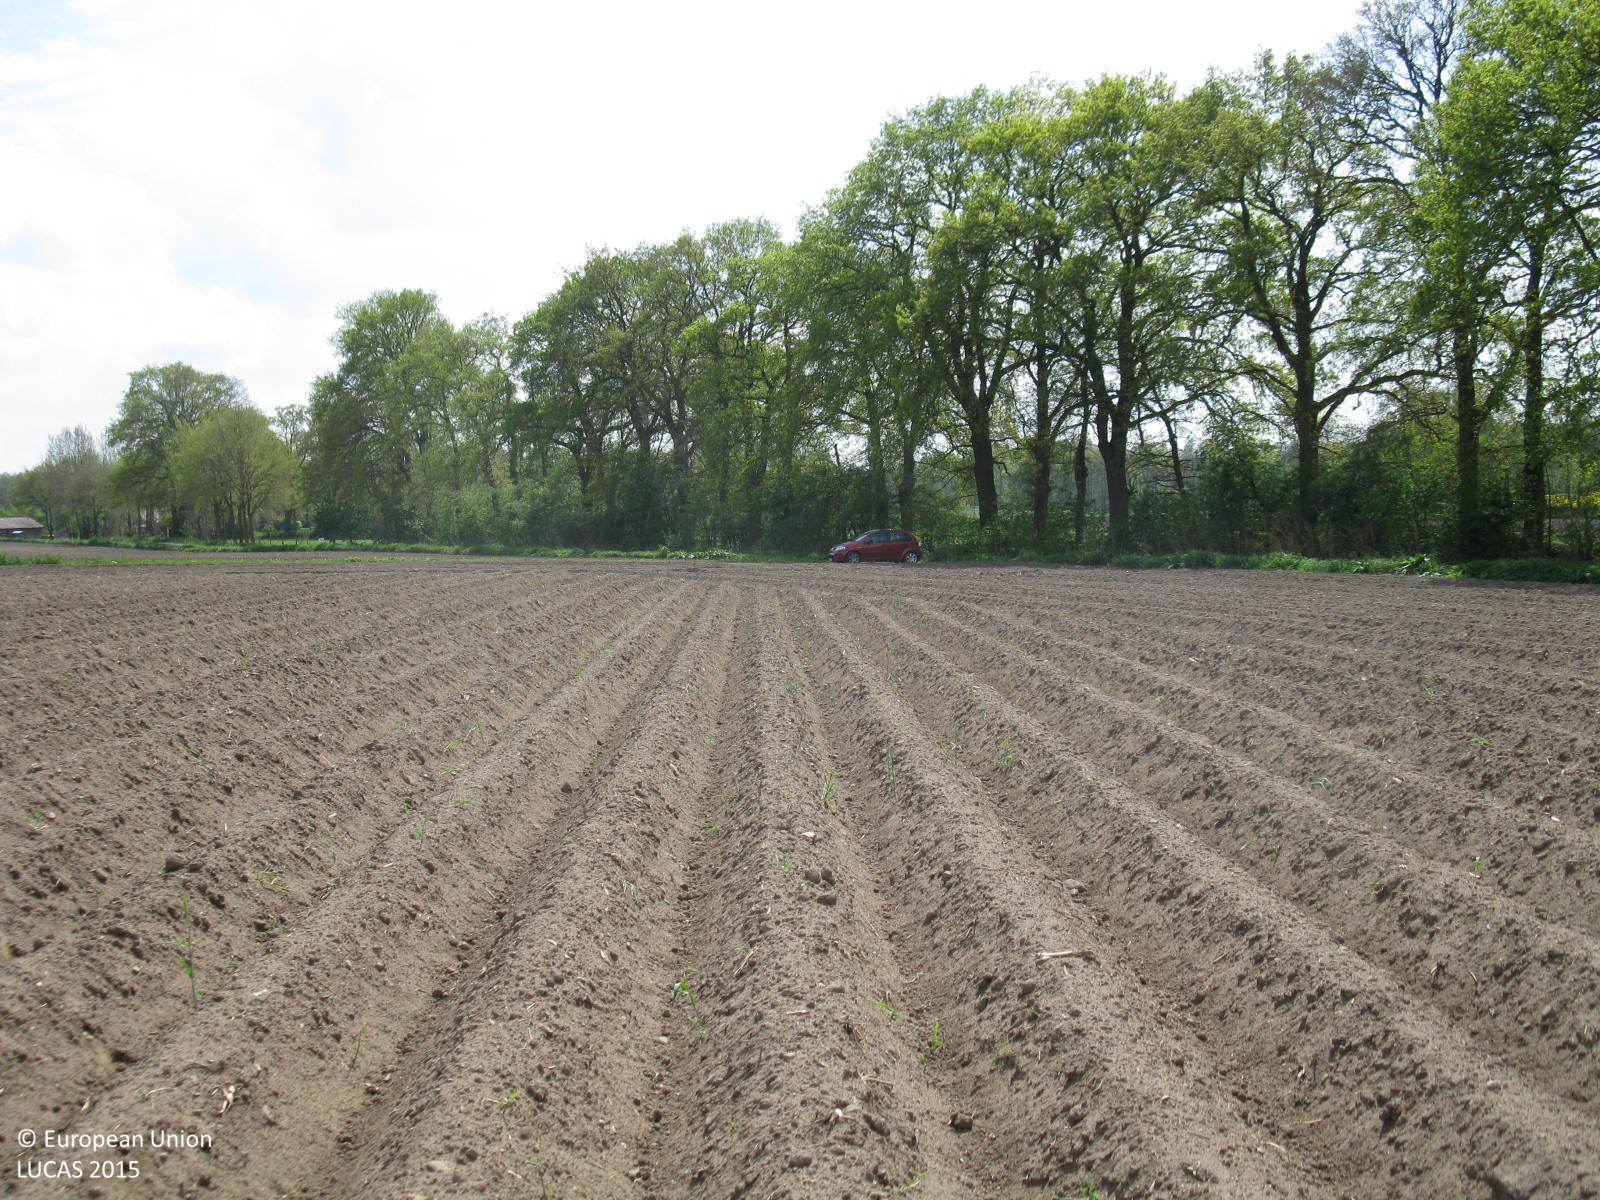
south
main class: Cropland
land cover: Potatoes
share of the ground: < 10 %
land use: Agriculture (excluding fallow land and kitchen gardens)
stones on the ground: < 10 %
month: May
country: DE
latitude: 52.8091
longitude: 7.9385
